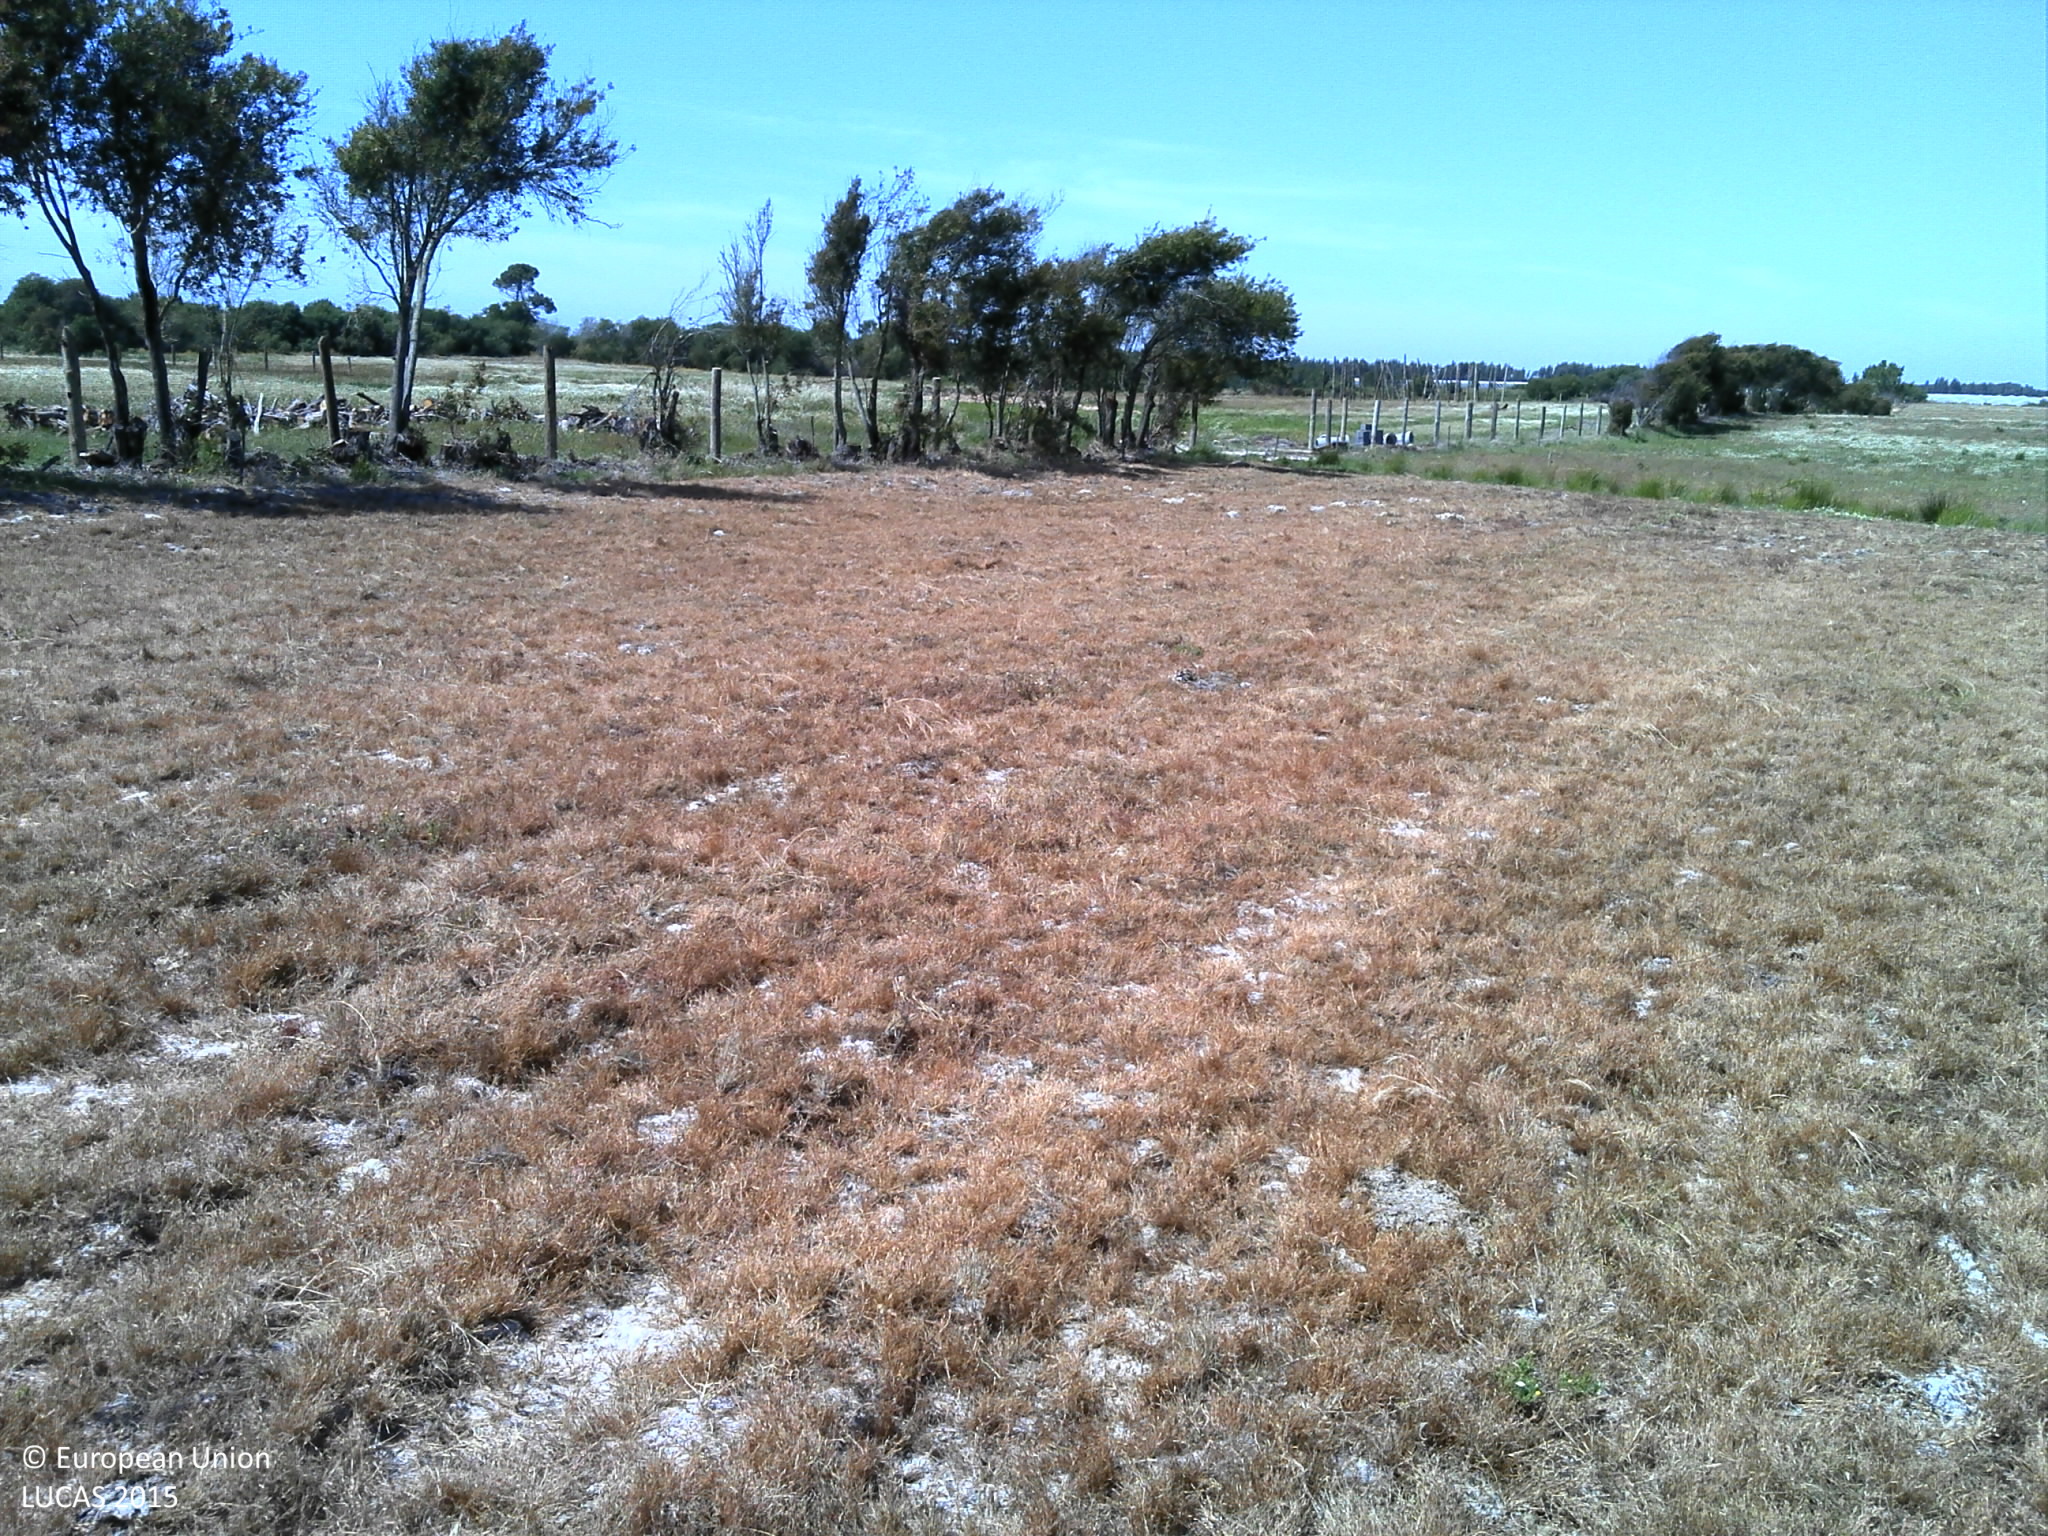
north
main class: Grassland
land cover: Grassland without tree/shrub cover
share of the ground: > 75 %
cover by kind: herbaceous plants 80 %, consolidated bare surface 20 %
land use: Agriculture (excluding fallow land and kitchen gardens)
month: May
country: PT
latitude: 37.5298
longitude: -8.7679
